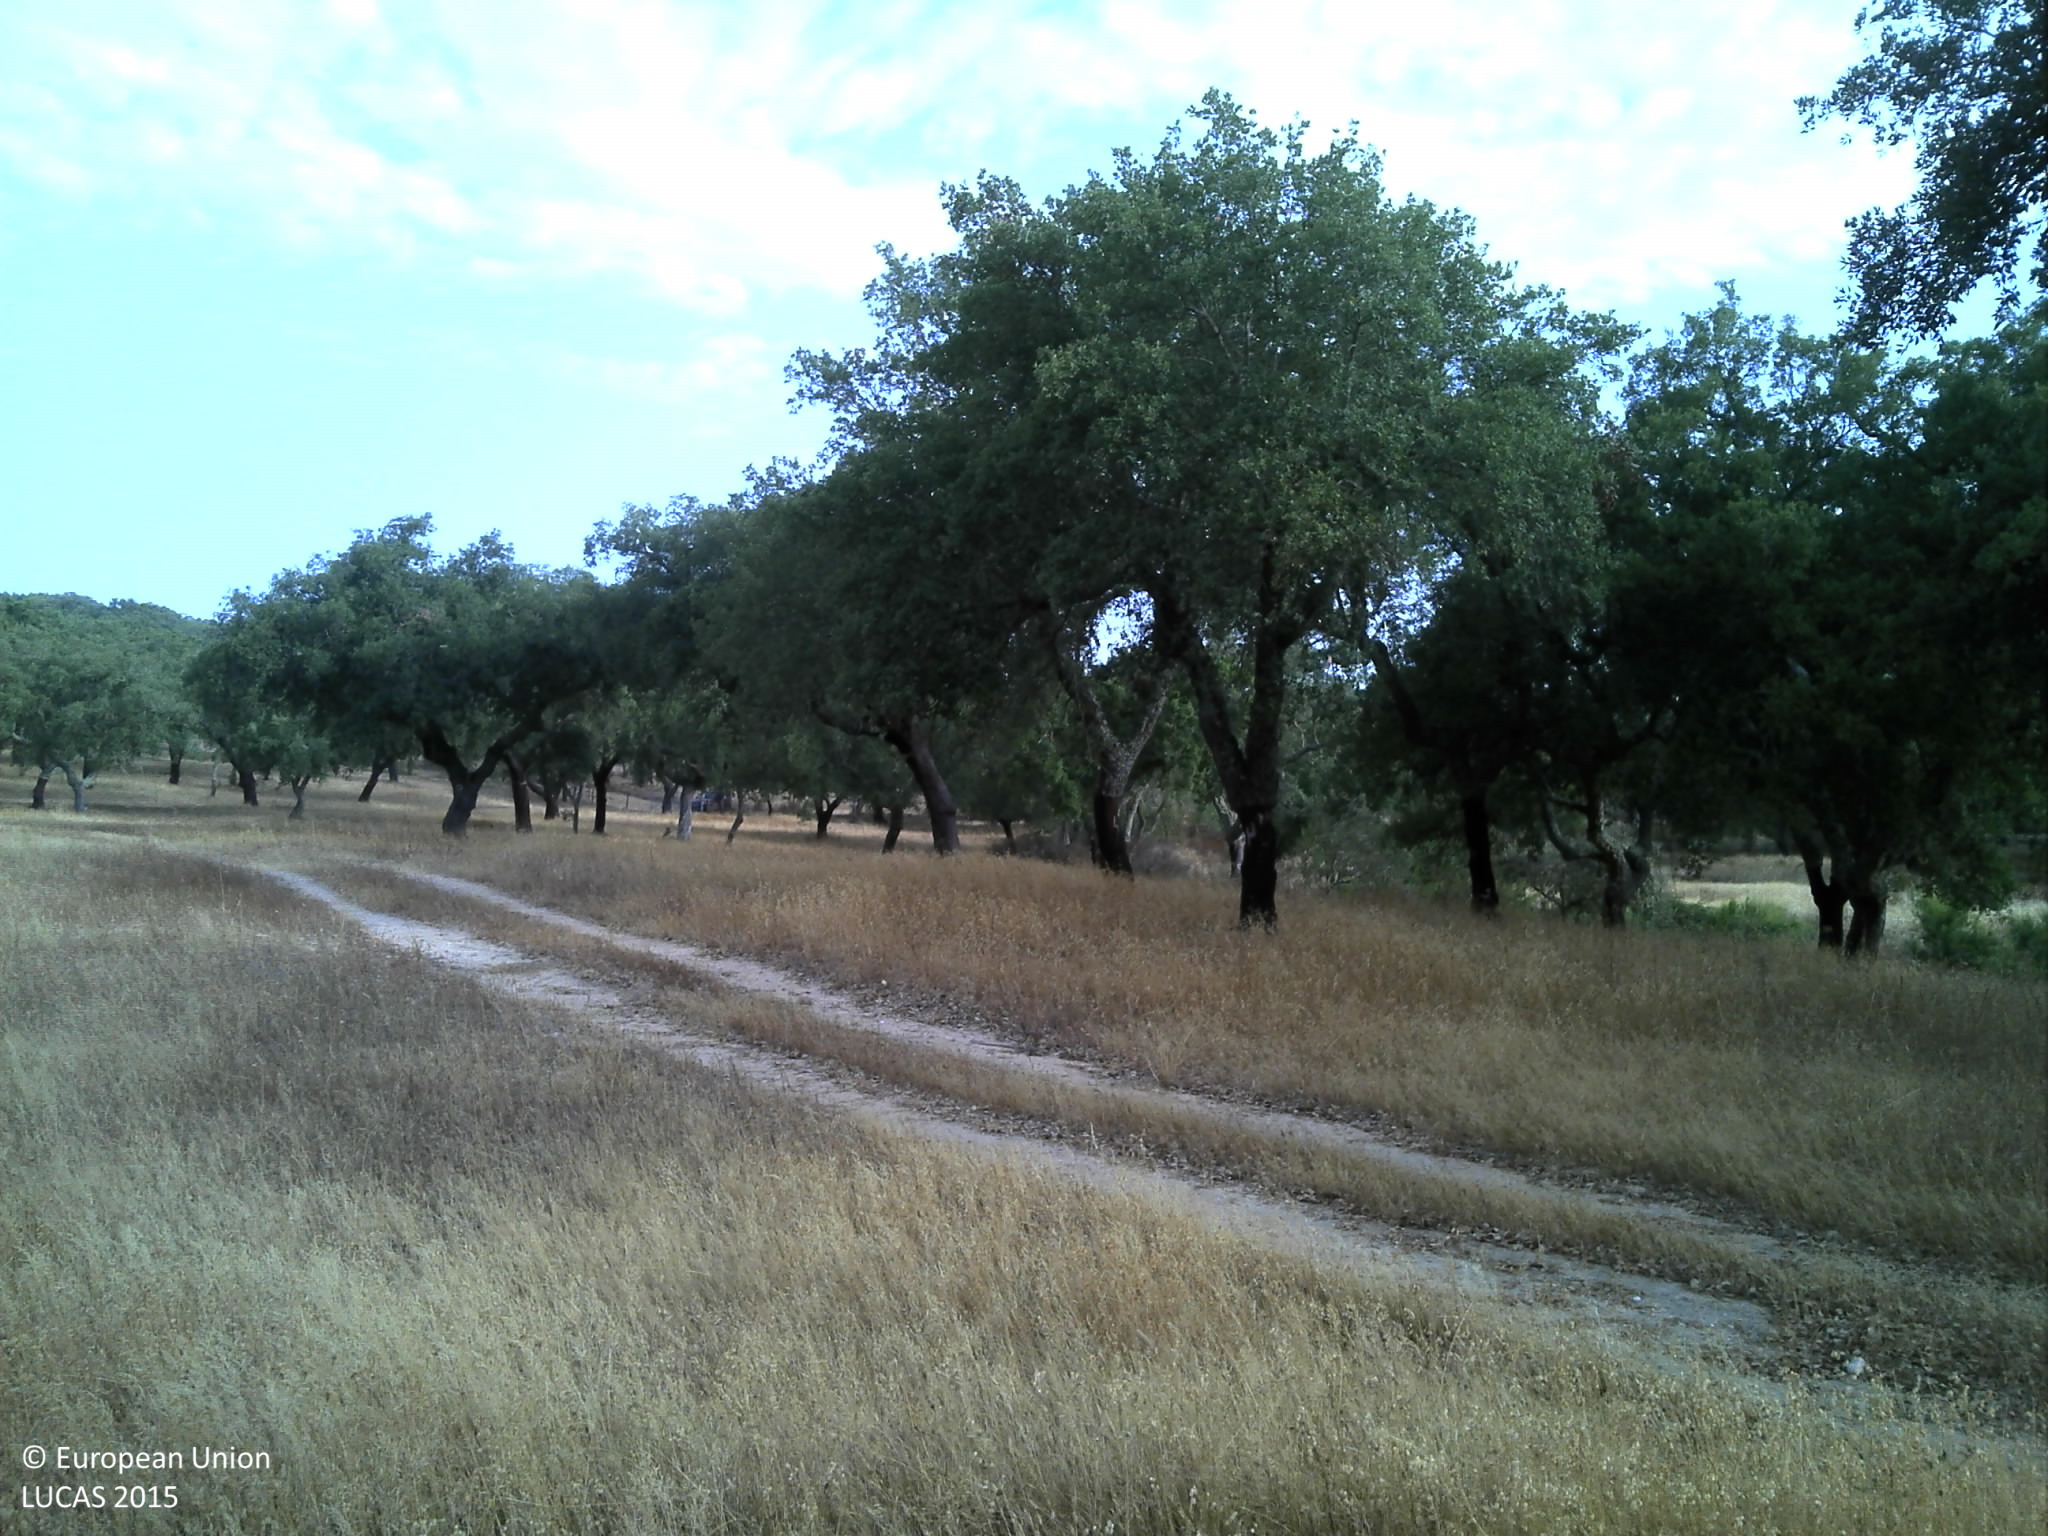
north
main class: Woodland
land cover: Broadleaved woodland
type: broadleaved evergreen forest
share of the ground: 25 - 50 %
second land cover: Grassland without tree/shrub cover
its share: 25 - 50 %
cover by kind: herbaceous plants 50 %, broadleaved forest trees 30 %, unconsolidated bare surface 20 %
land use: Forestry
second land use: Agriculture (excluding fallow land and kitchen gardens)
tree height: > 5 m
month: July
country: PT
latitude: 38.7281
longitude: -7.7412
